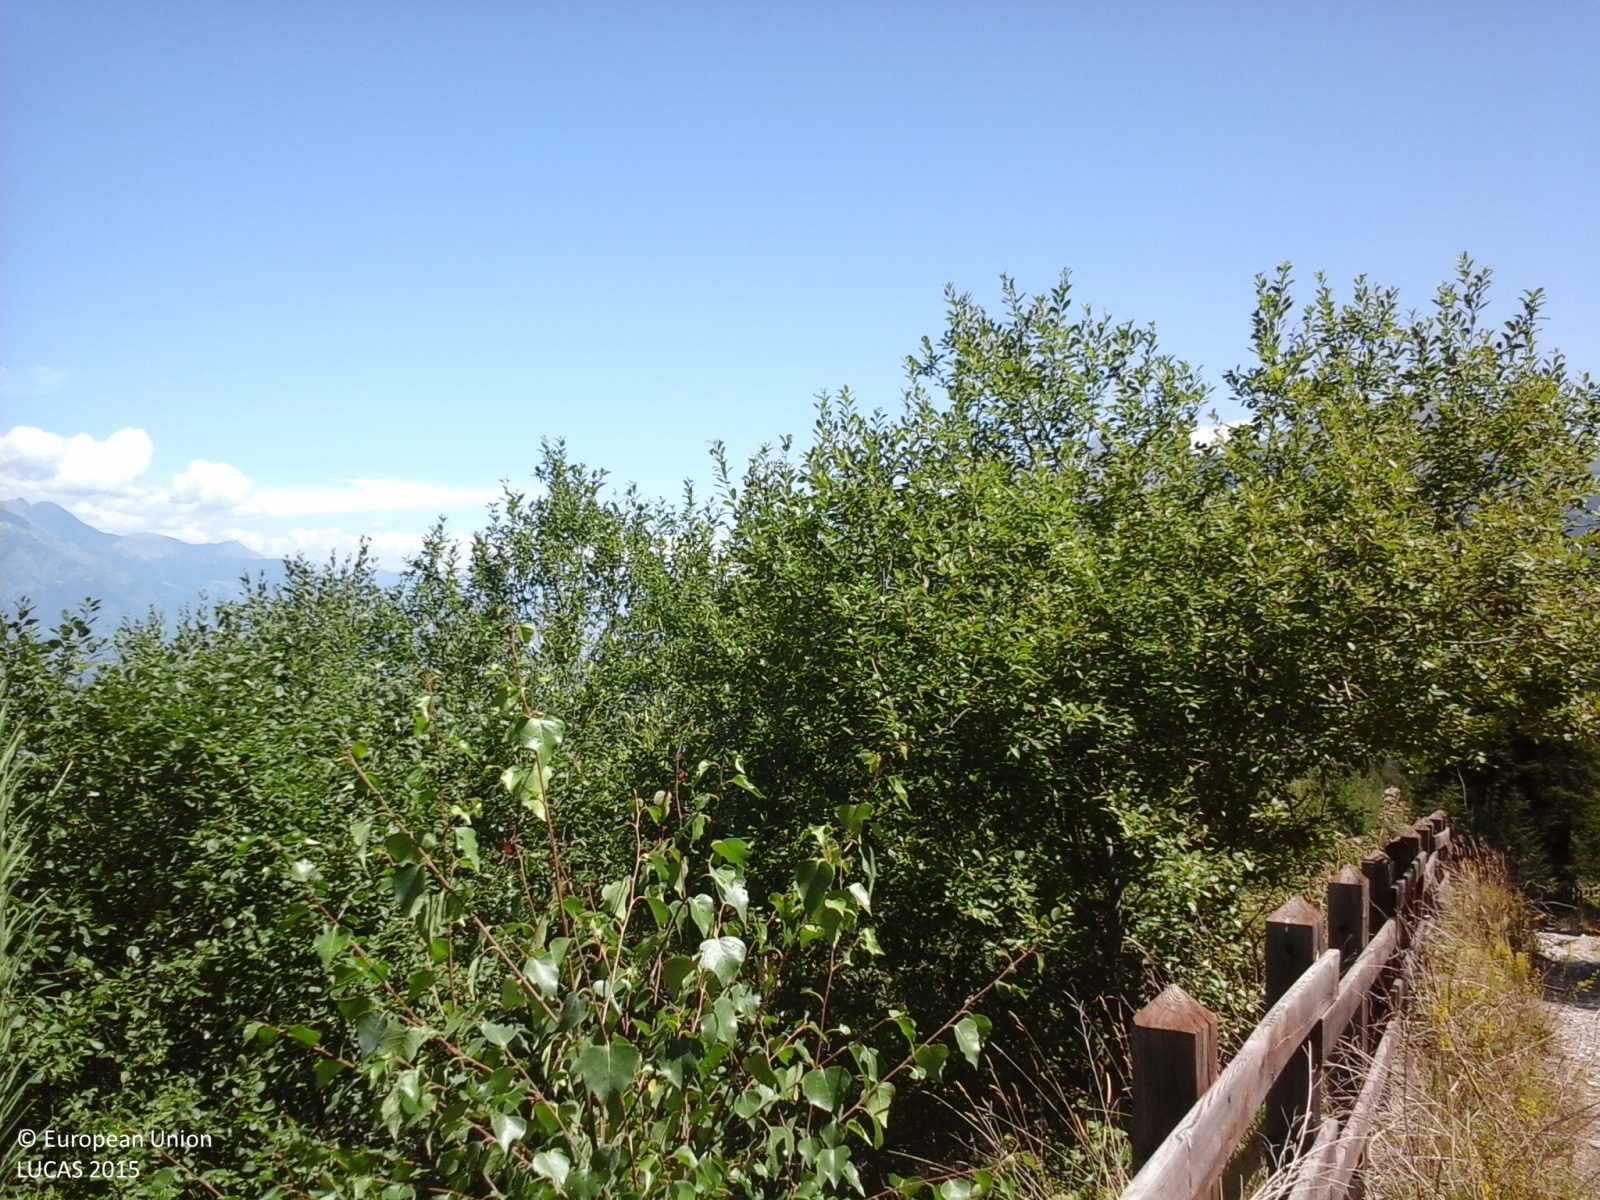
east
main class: Woodland
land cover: Spruce dominated mixed woodland
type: mesophytic deciduous forest
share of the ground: > 75 %
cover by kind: coniferous forest trees 50 %, broadleaved forest trees 40 %, shrubs 10 %
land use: Forestry
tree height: > 5 m
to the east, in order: Spruce dominated mixed woodland; Dry stone walls; Tracks; Spruce dominated mixed woodland
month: August
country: IT
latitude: 45.6828
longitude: 7.1664
